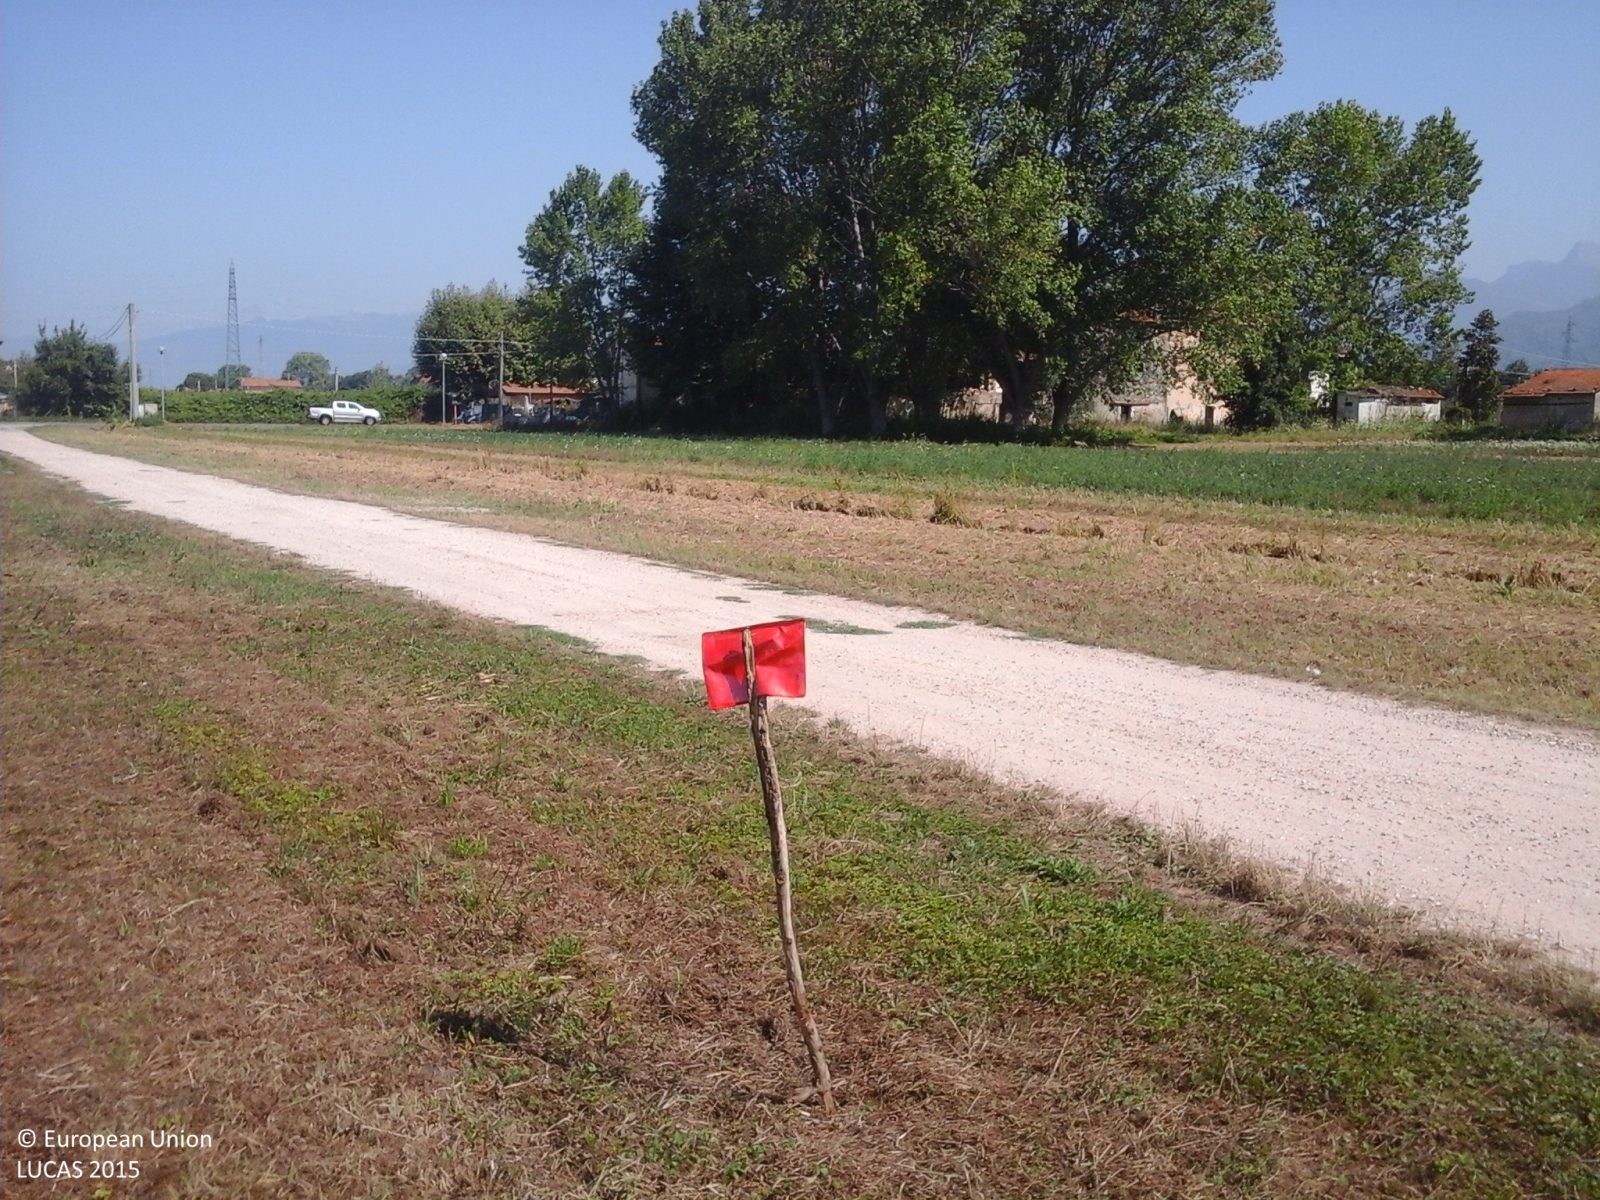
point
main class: Grassland
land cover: Spontaneously vegetated surfaces
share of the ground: > 75 %
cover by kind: herbaceous plants 100 %
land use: Fallow land
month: August
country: IT
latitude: 43.8812
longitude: 10.2607
